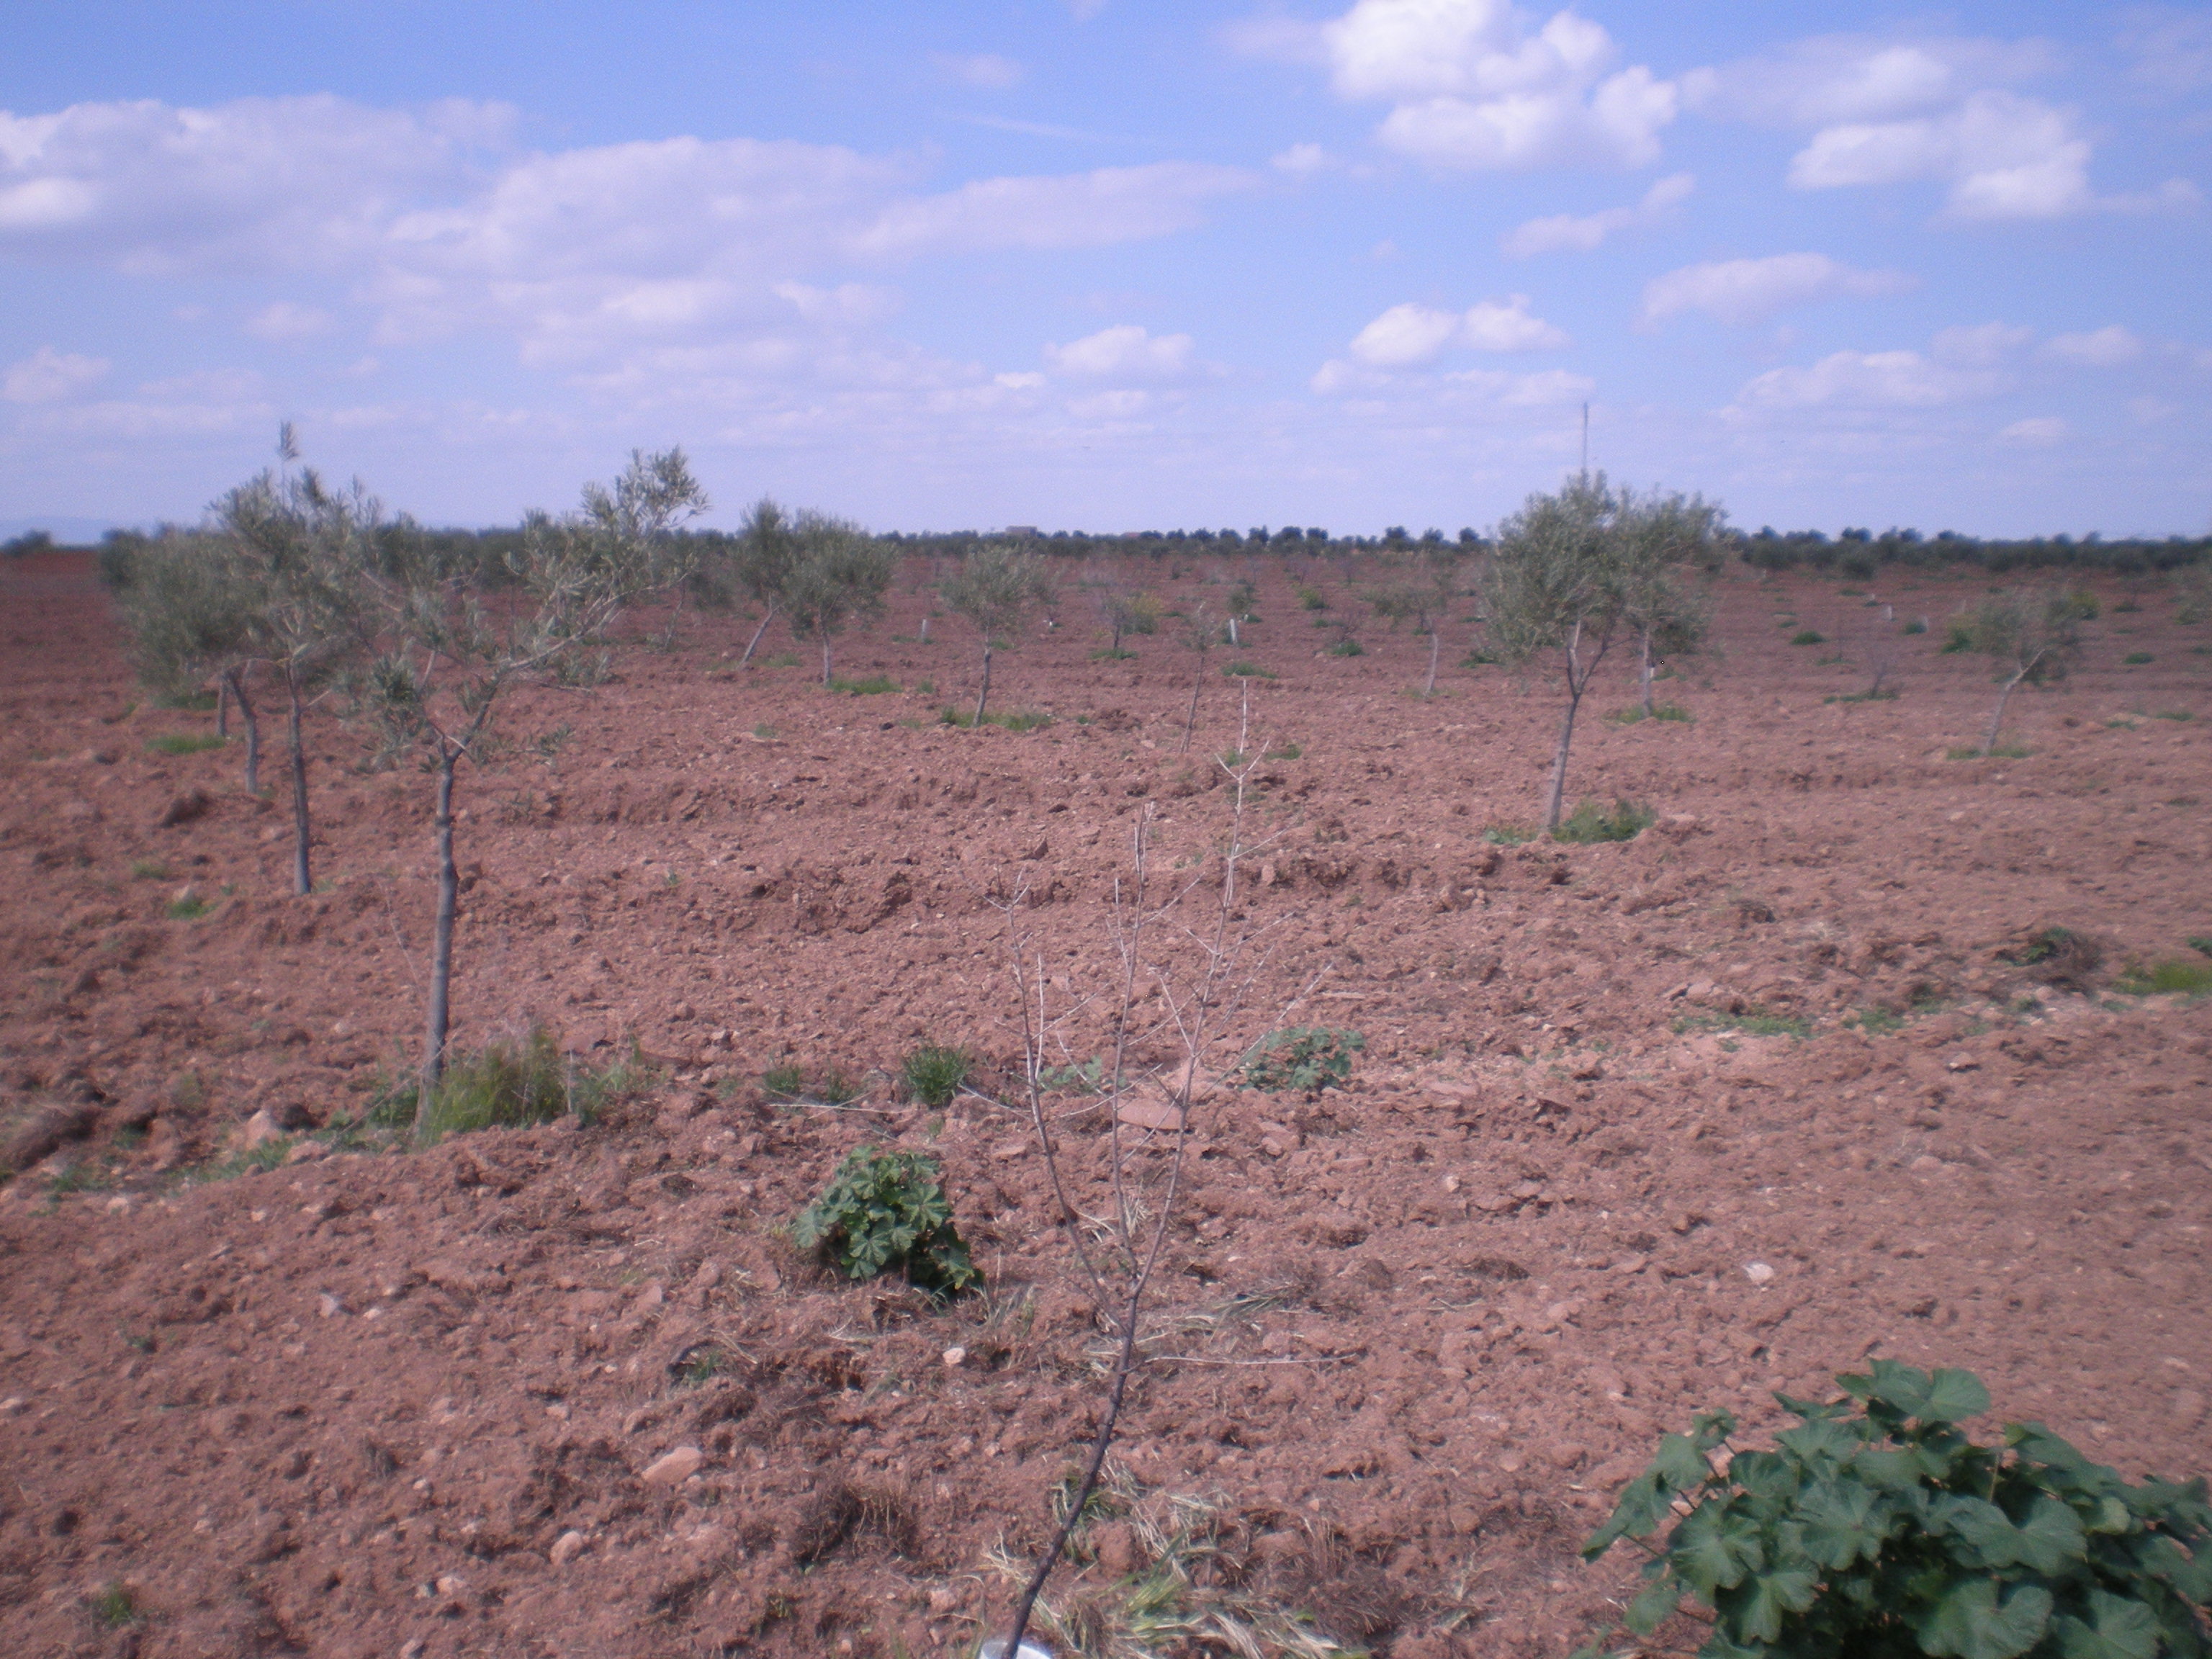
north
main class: Cropland
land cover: Olive groves
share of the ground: < 10 %
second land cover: Other bare soil
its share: > 75 %
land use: Agriculture (excluding fallow land and kitchen gardens)
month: April
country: ES
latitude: 38.9266
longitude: -3.4988
